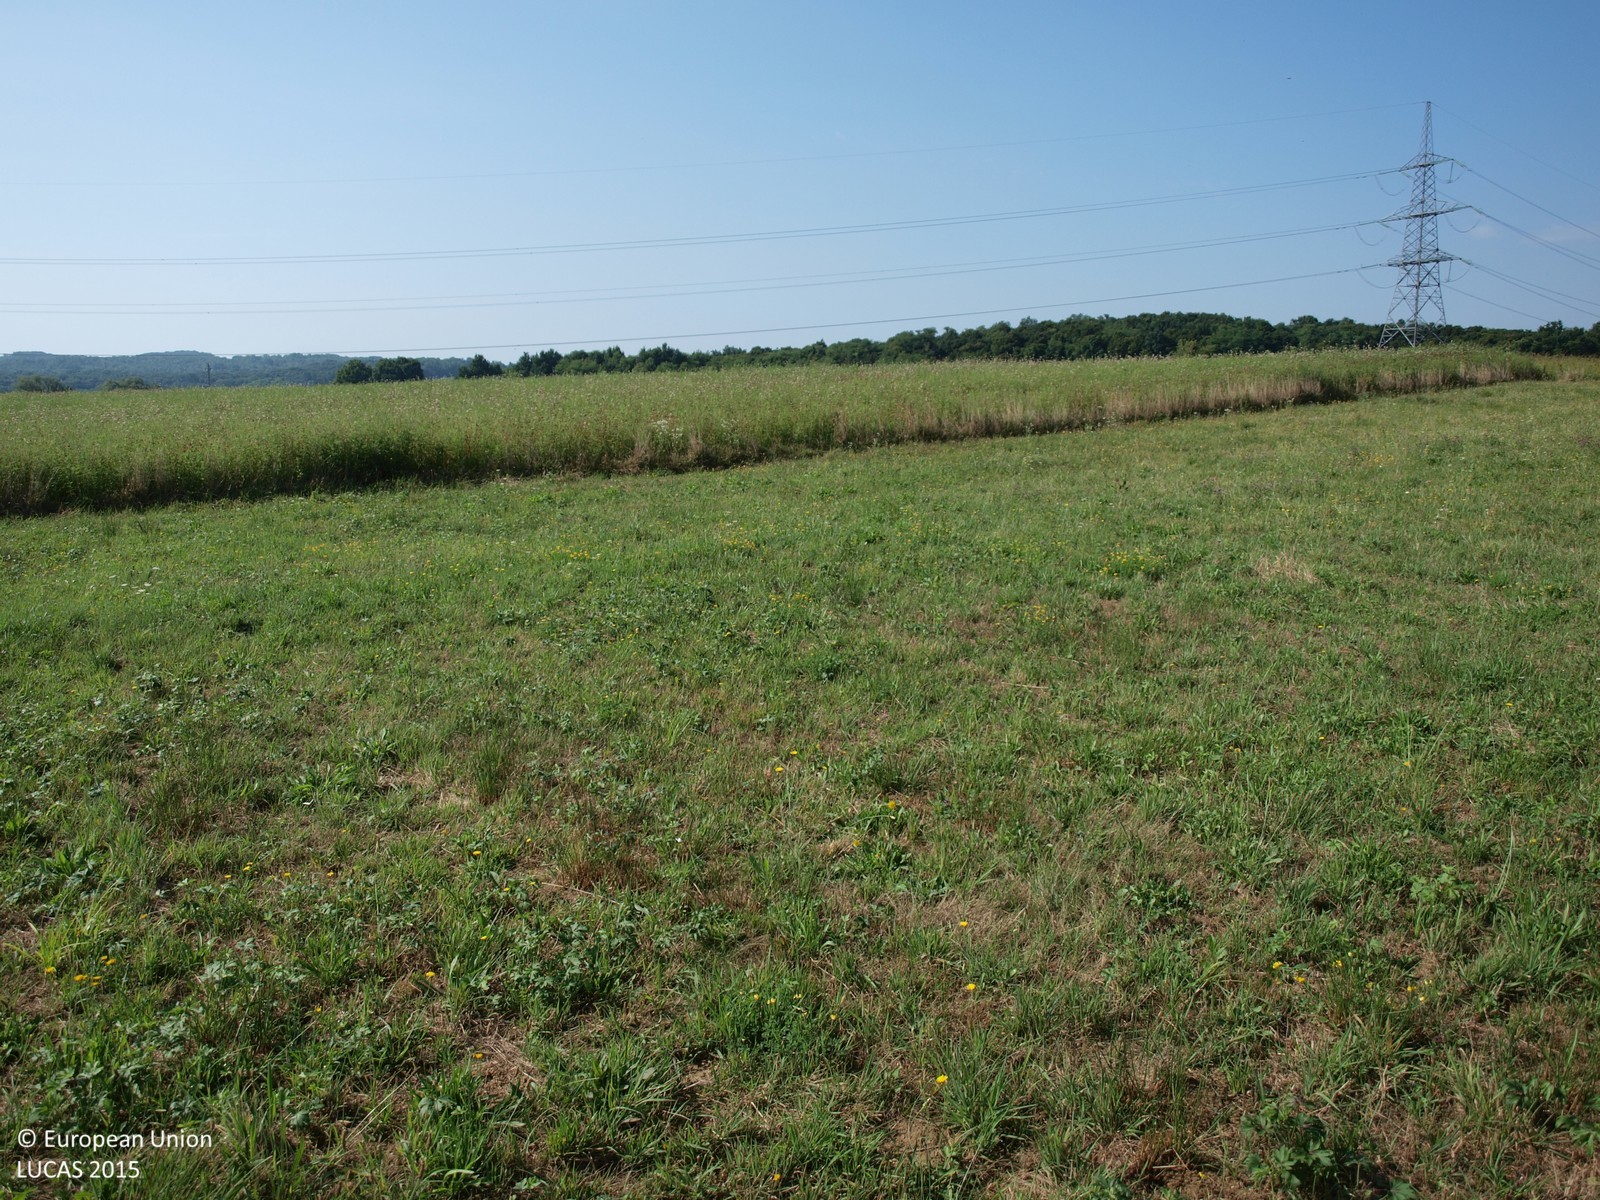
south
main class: Grassland
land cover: Grassland without tree/shrub cover
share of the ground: > 75 %
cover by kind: herbaceous plants 100 %
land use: Agriculture (excluding fallow land and kitchen gardens)
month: August
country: HR
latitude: 45.8974
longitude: 16.2497
